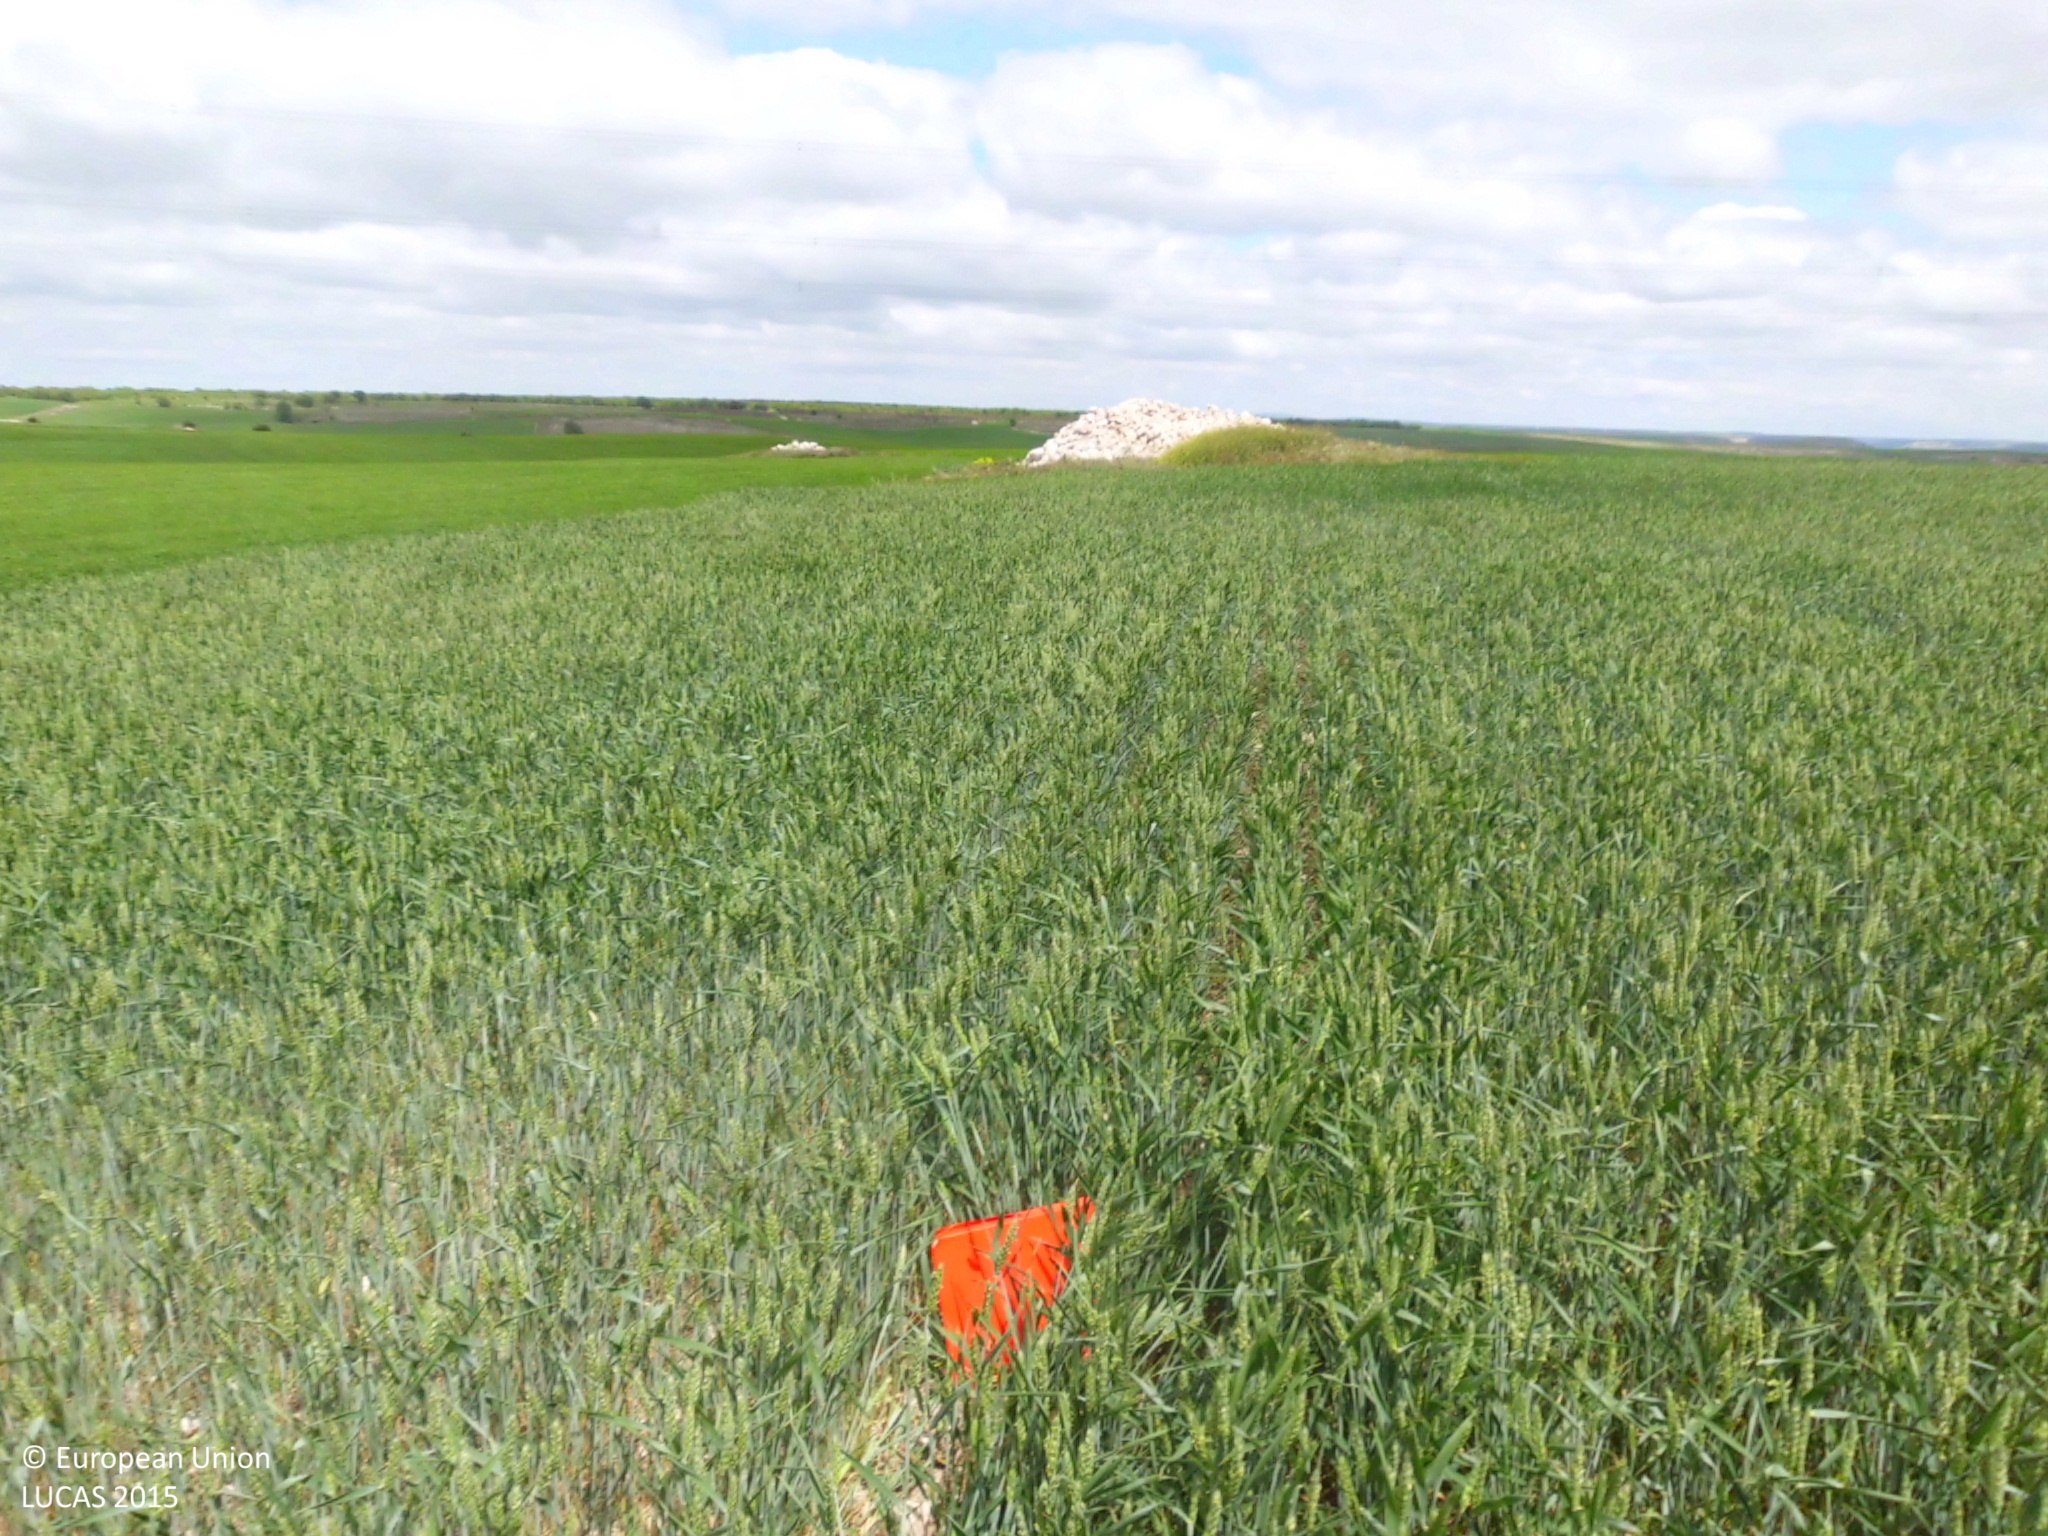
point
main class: Cropland
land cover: Common wheat
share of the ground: > 75 %
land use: Agriculture (excluding fallow land and kitchen gardens)
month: May
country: ES
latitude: 42.3359
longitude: -3.8626
